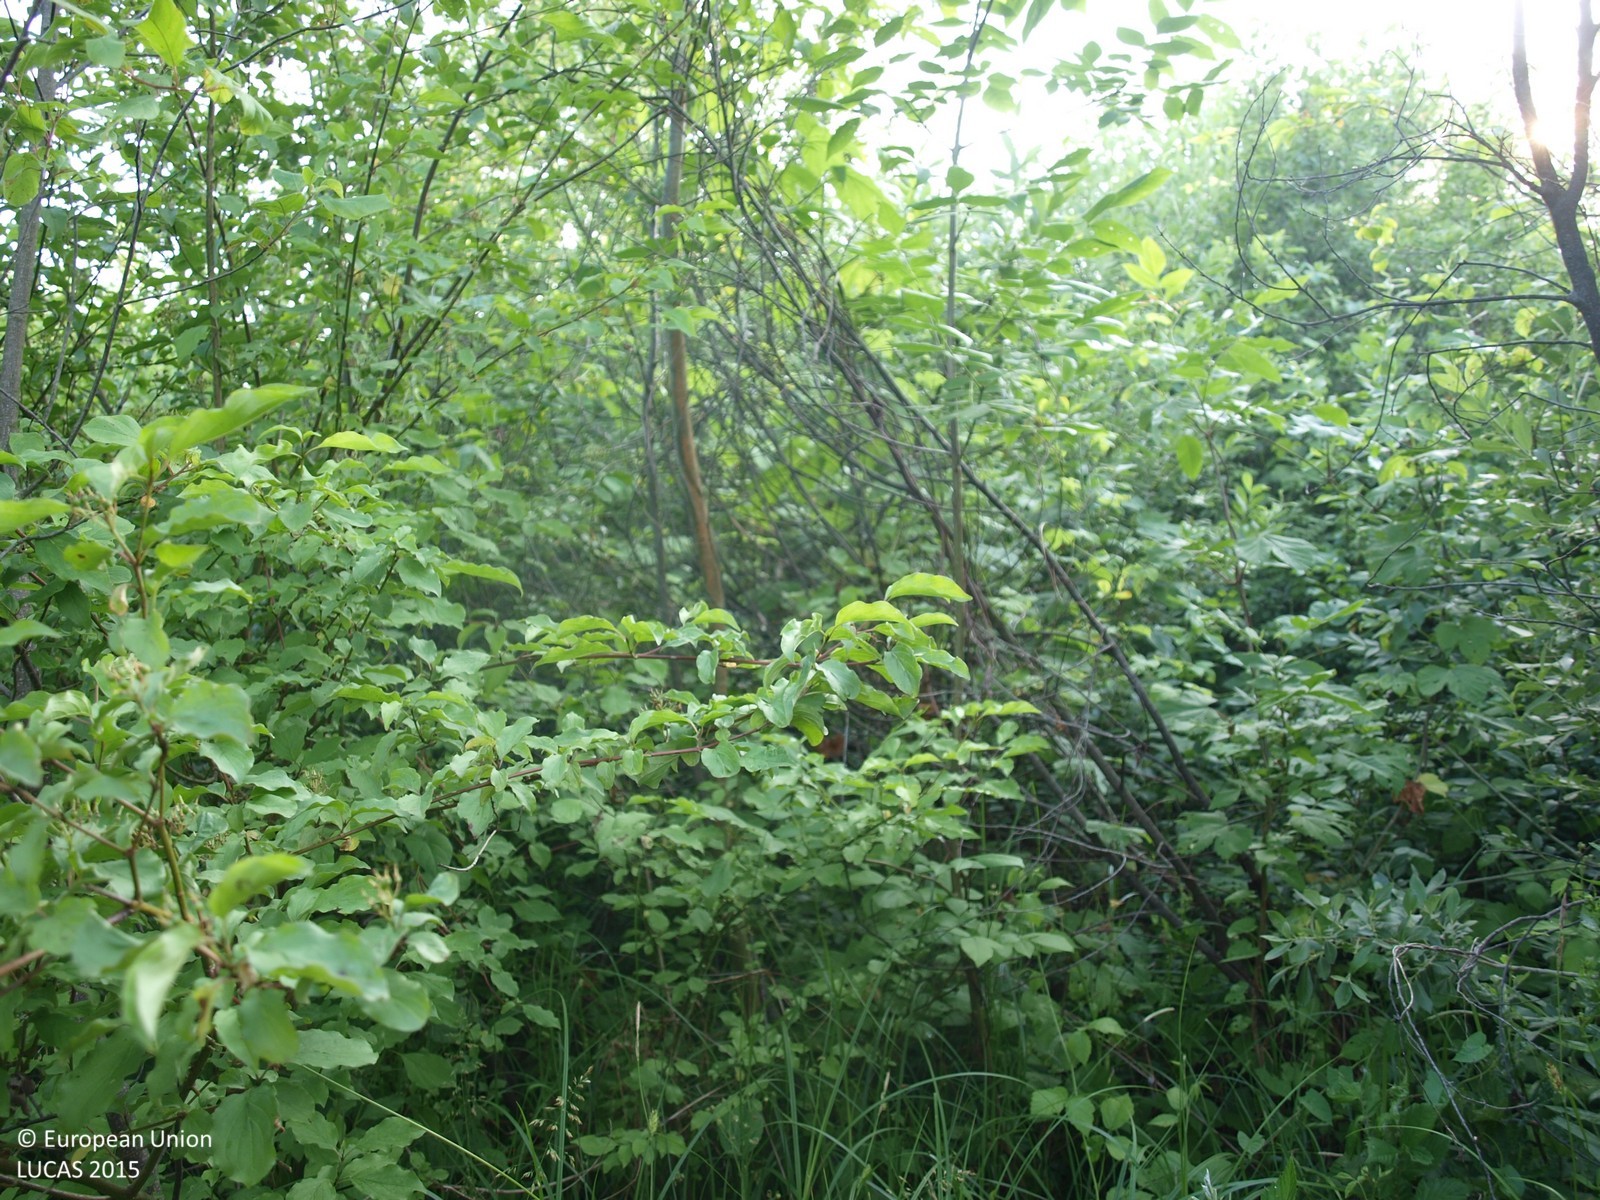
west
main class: Shrubland
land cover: Shrubland with sparse tree cover
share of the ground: > 75 %
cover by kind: shrubs 95 %, broadleaved forest trees 5 %
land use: Abandoned areas
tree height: > 5 m
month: June
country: HR
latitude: 45.7993
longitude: 15.7485
